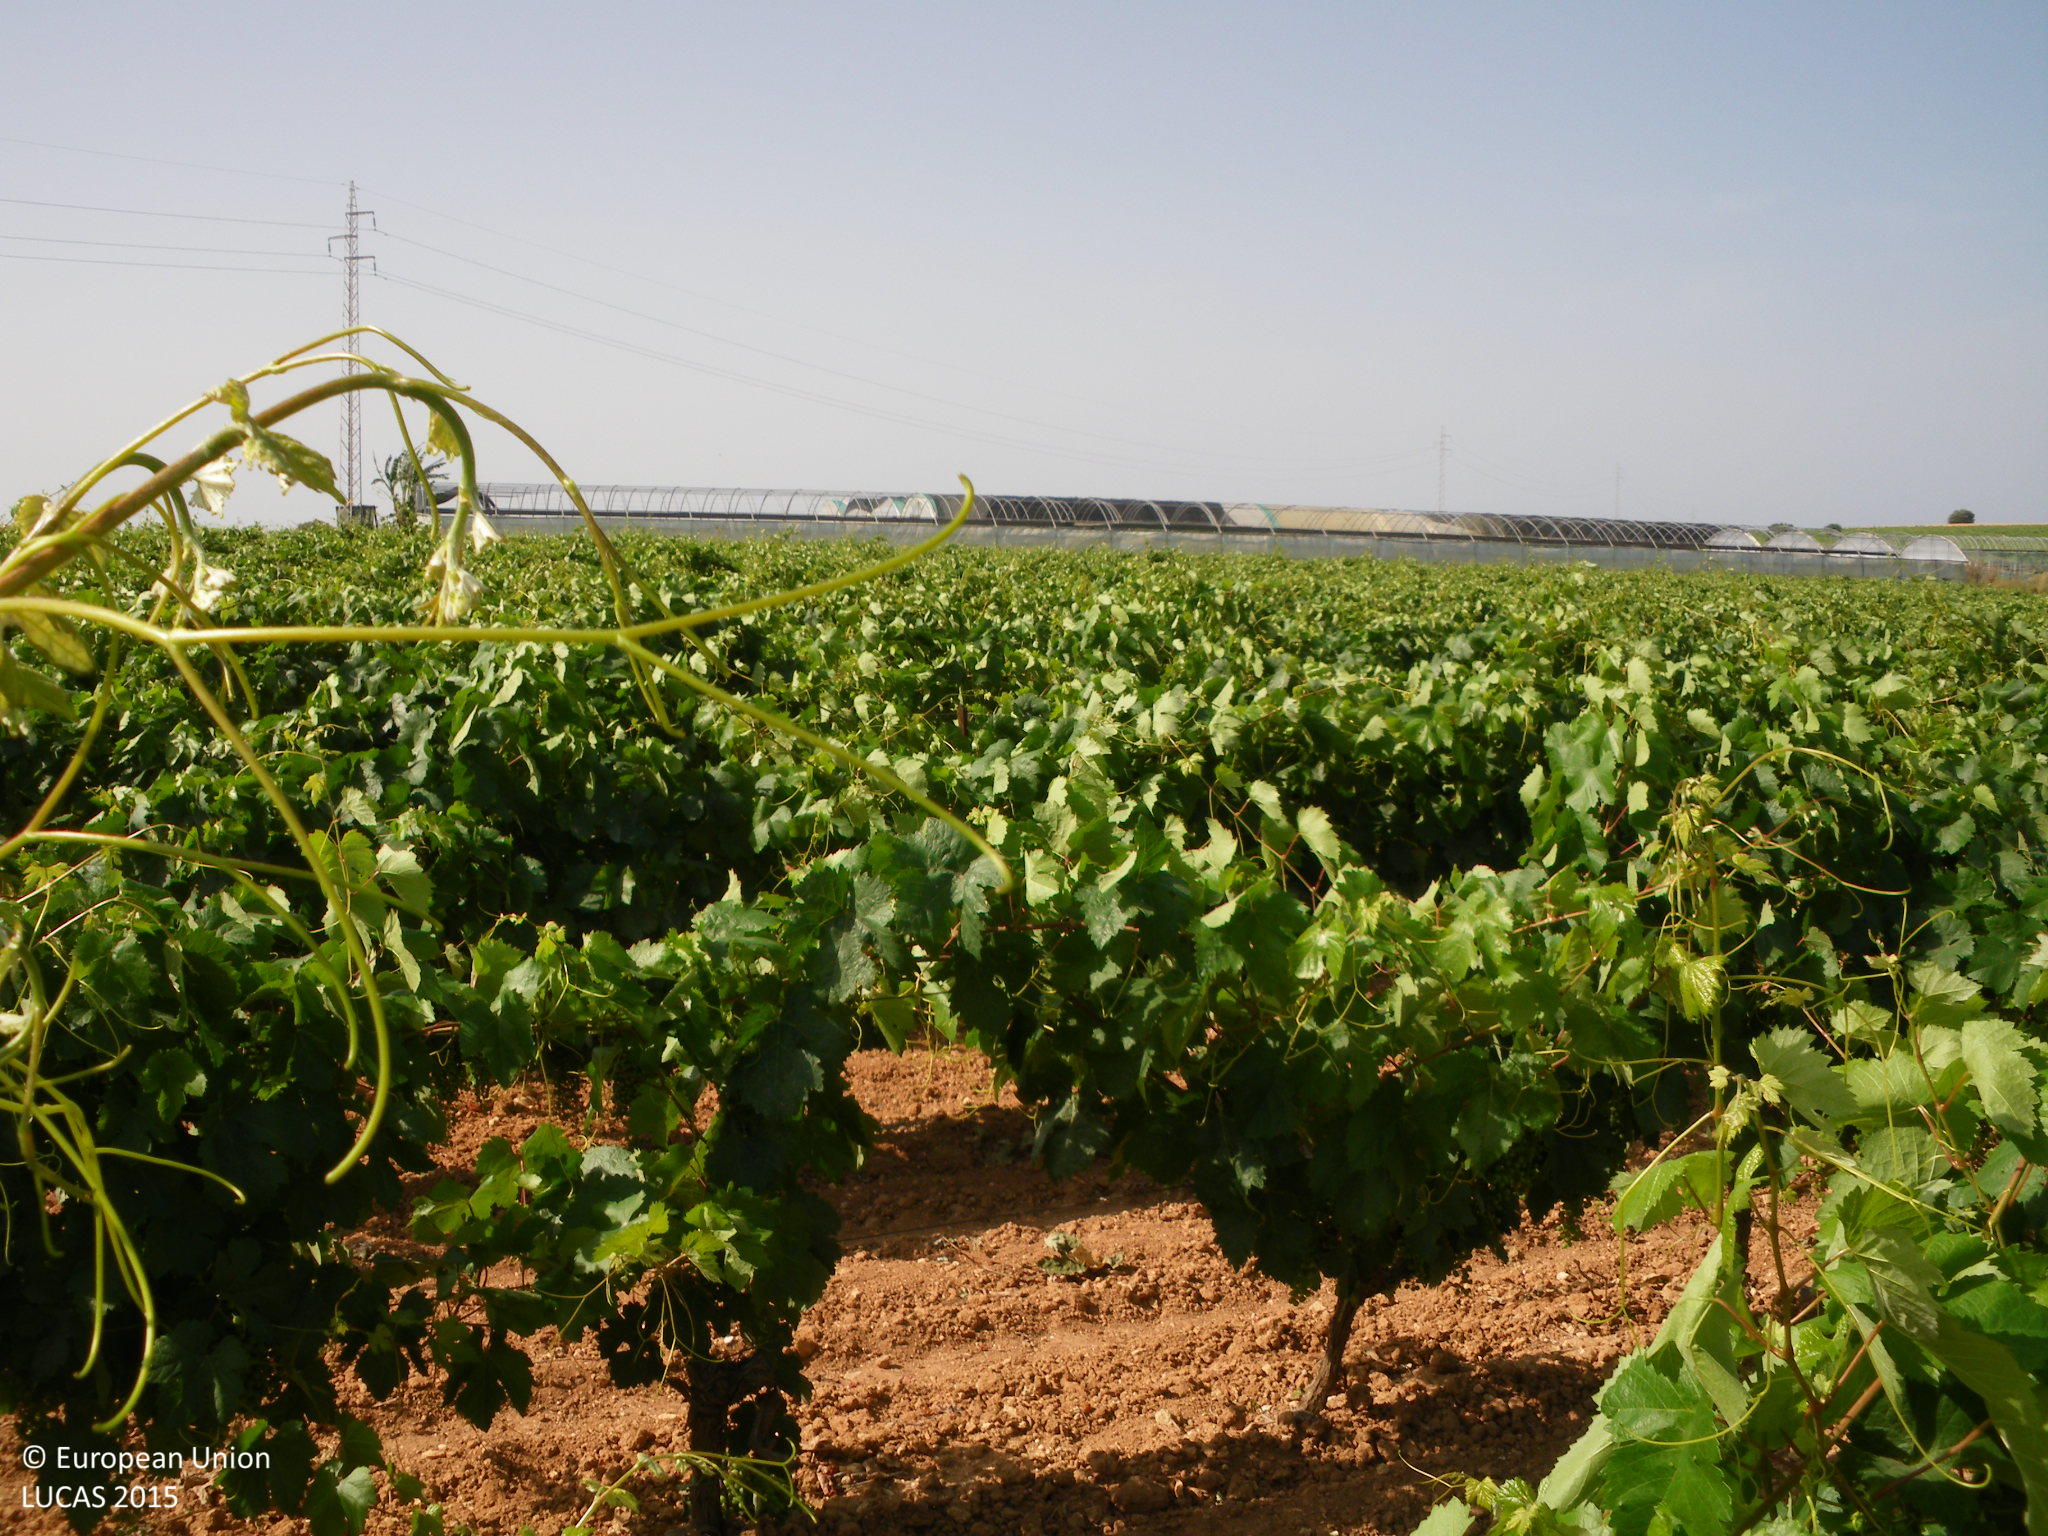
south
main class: Cropland
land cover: Vineyards
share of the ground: 25 - 50 %
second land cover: Other bare soil
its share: > 75 %
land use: Agriculture (excluding fallow land and kitchen gardens)
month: June
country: ES
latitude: 36.7275
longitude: -6.3533
